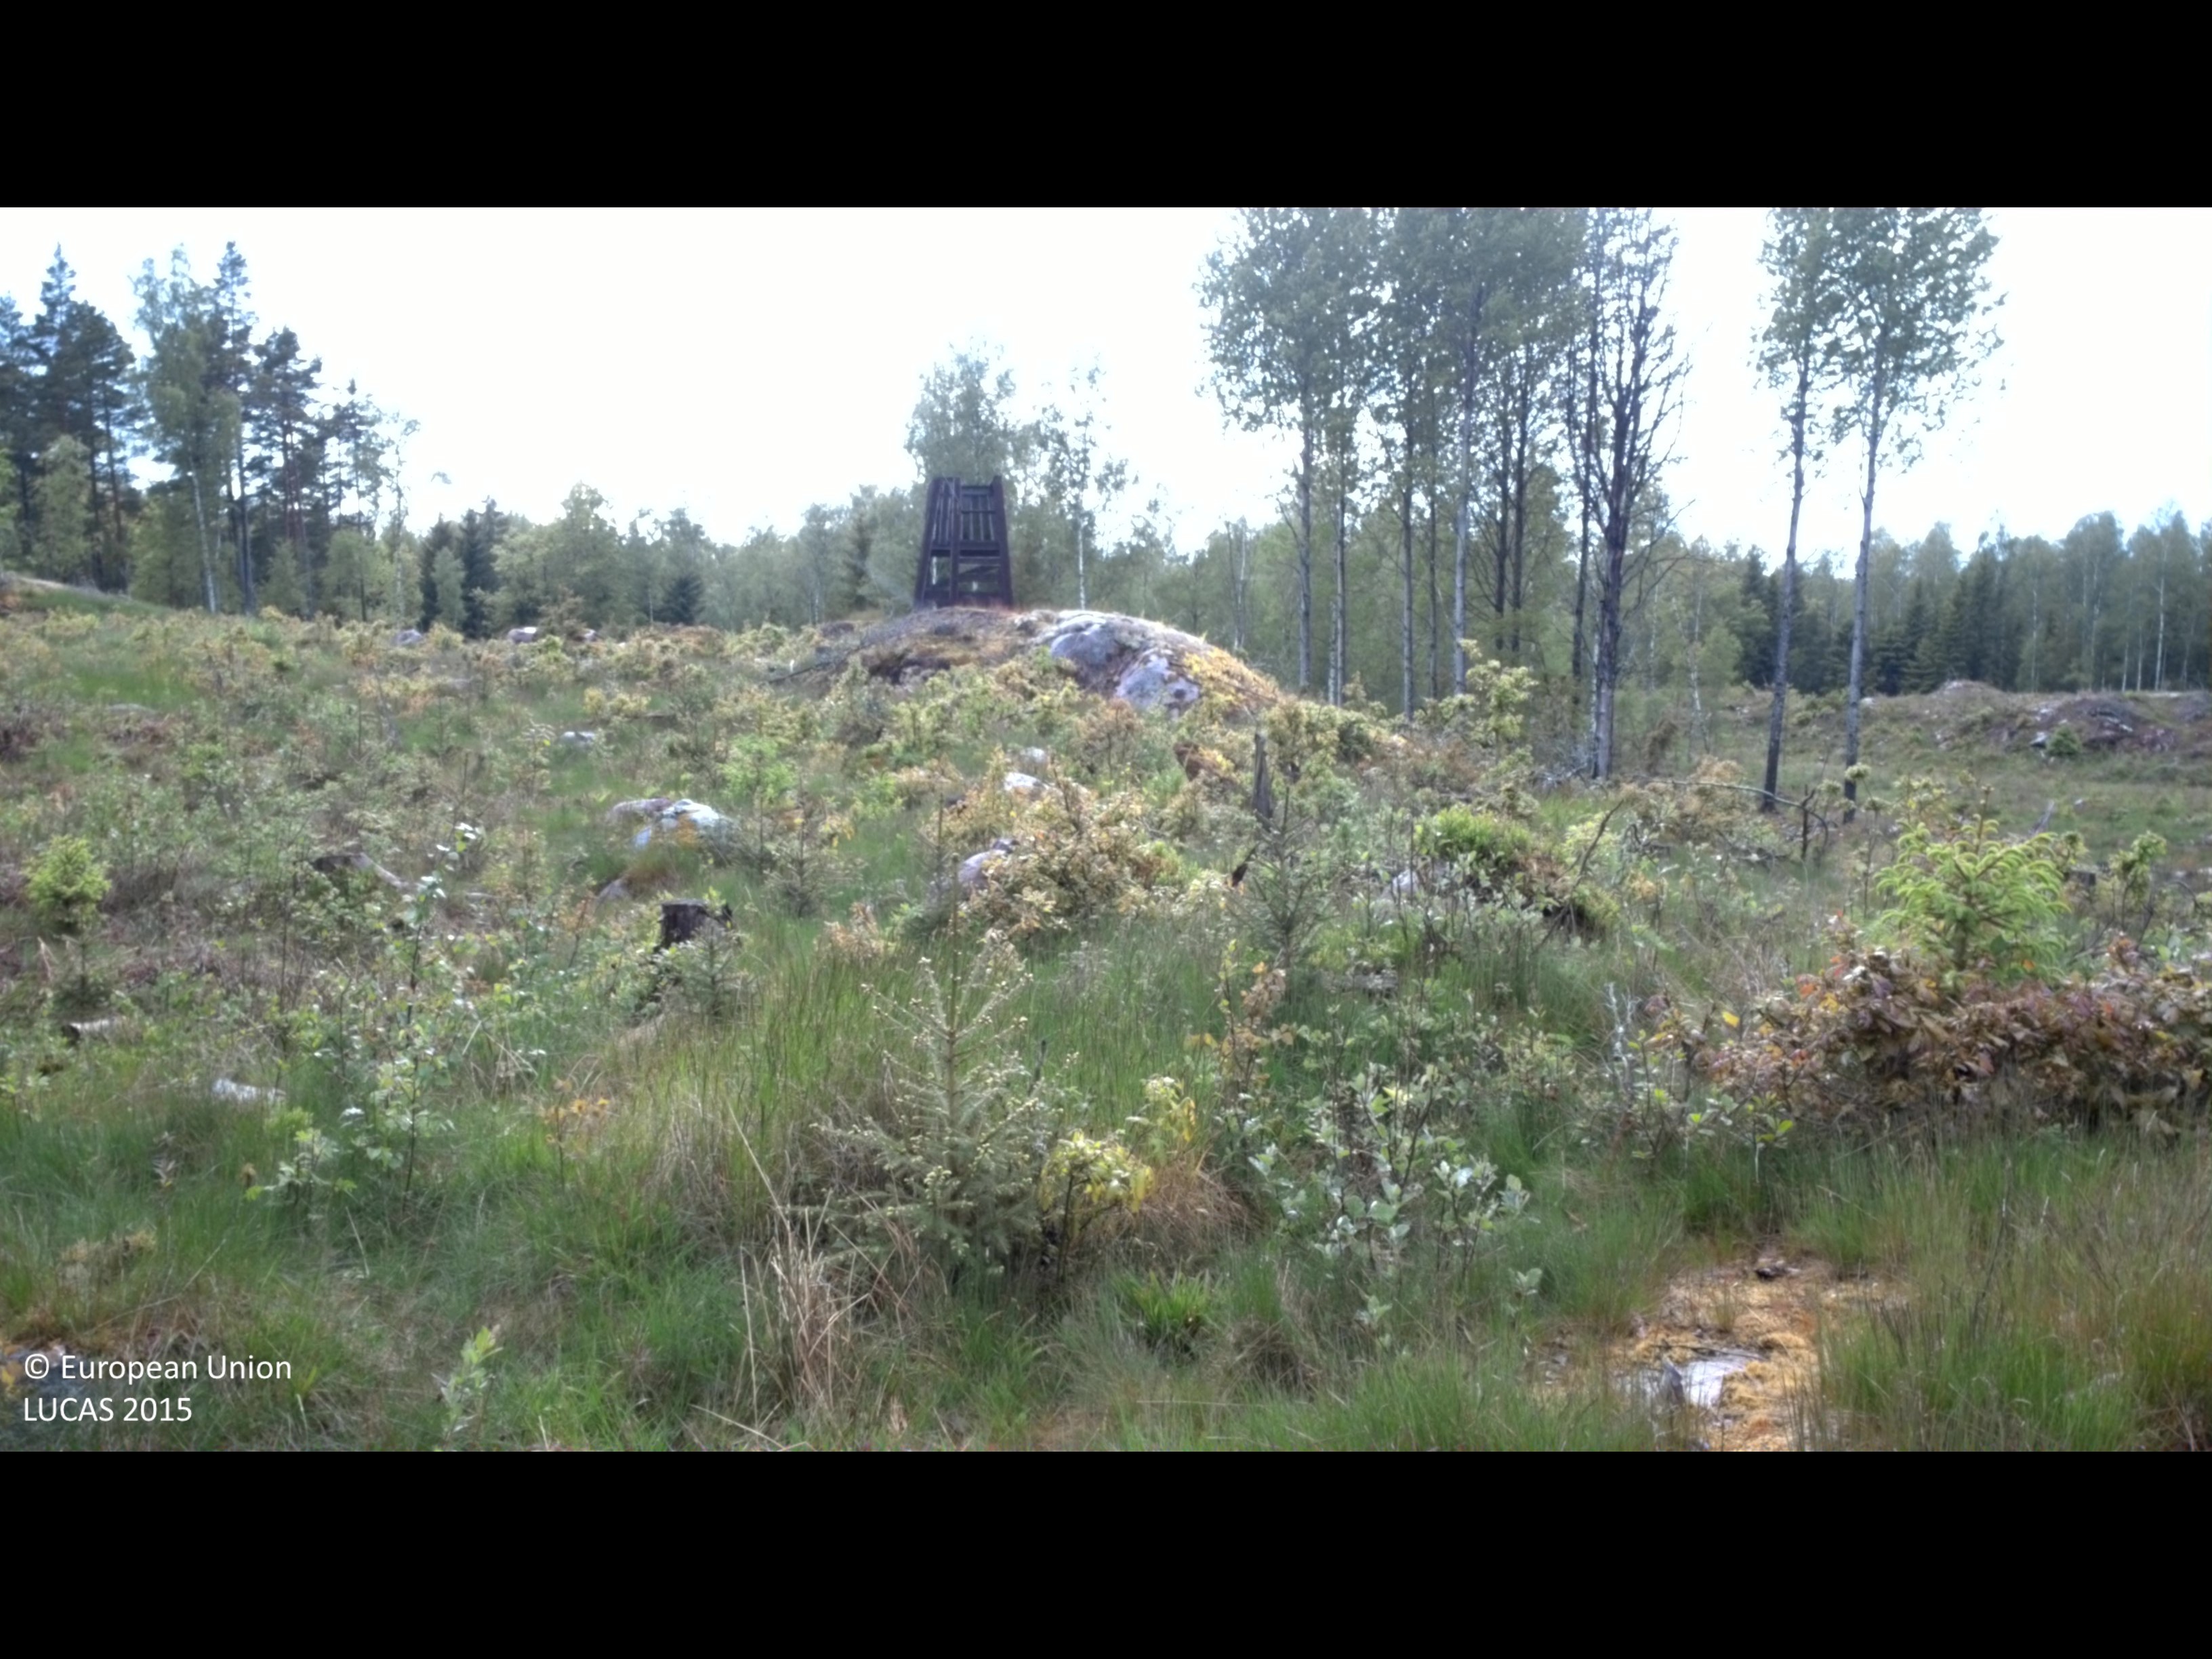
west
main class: Woodland
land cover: Broadleaved woodland
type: hemiboreal forest and nemoral coniferous forest and mixed broadleaved-coniferous forest
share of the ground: 25 - 50 %
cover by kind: broadleaved forest trees 40 %, shrubs 25 %, herbaceous plants 20 %, coniferous forest trees 10 %, lichens and mosses 5 %
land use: Forestry
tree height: > 5 m
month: May
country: SE
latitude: 57.4462
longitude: 16.5479
